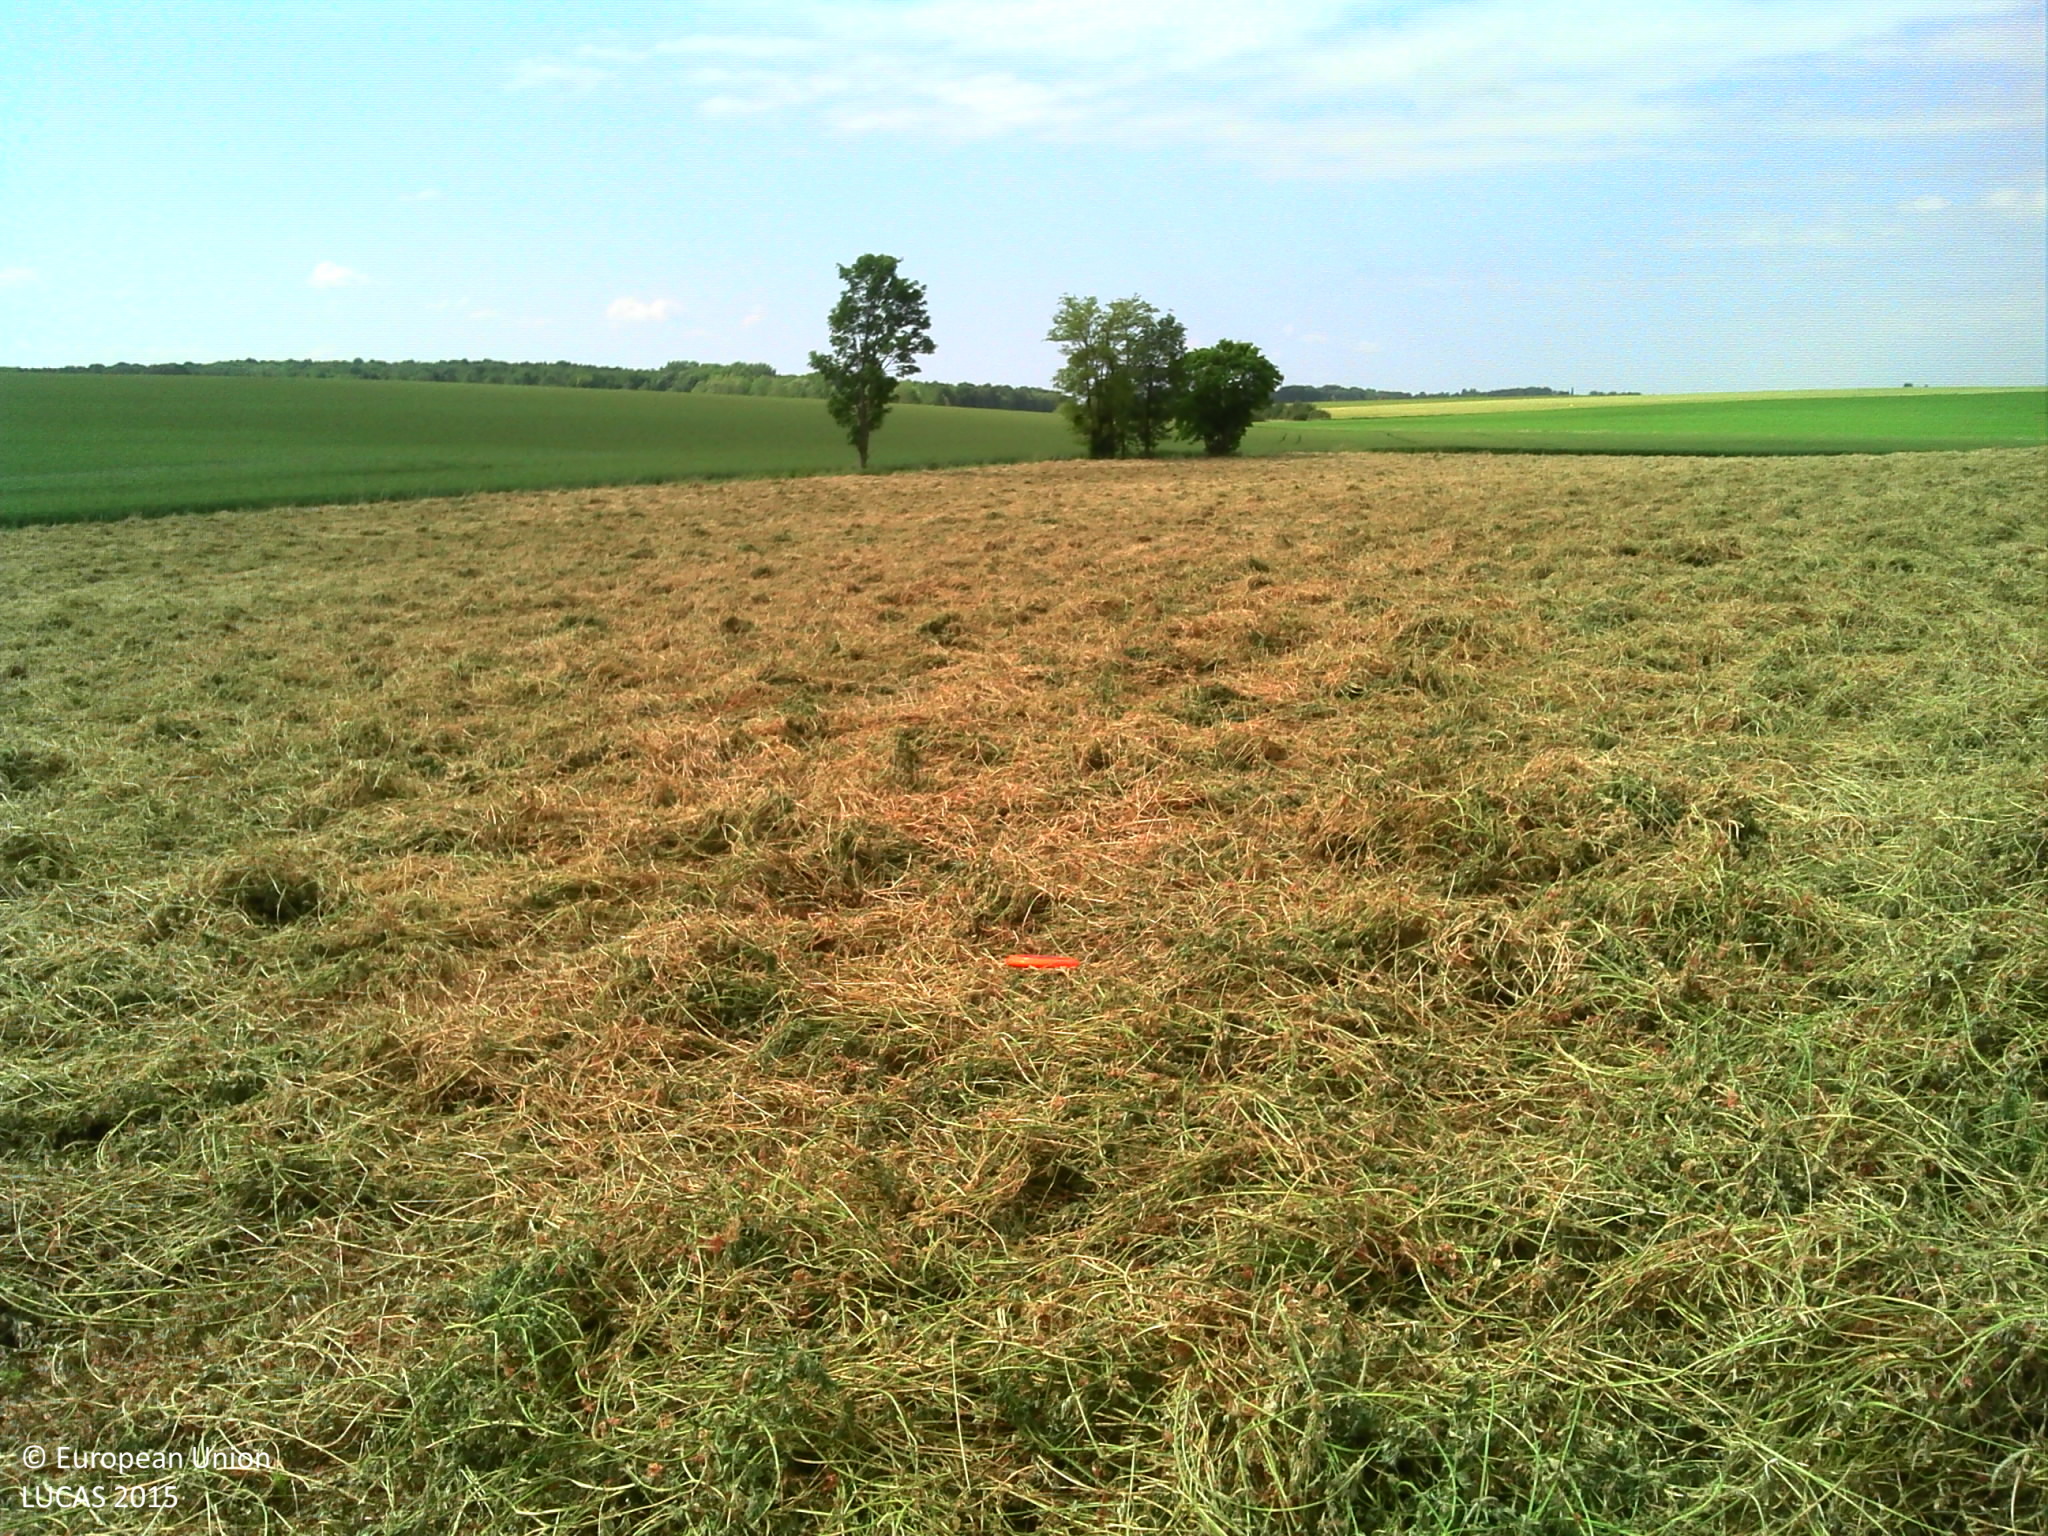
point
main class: Cropland
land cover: Lucerne
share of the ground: > 75 %
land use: Agriculture (excluding fallow land and kitchen gardens)
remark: Harvested field
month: May
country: FR
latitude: 47.3986
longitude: 5.2174
